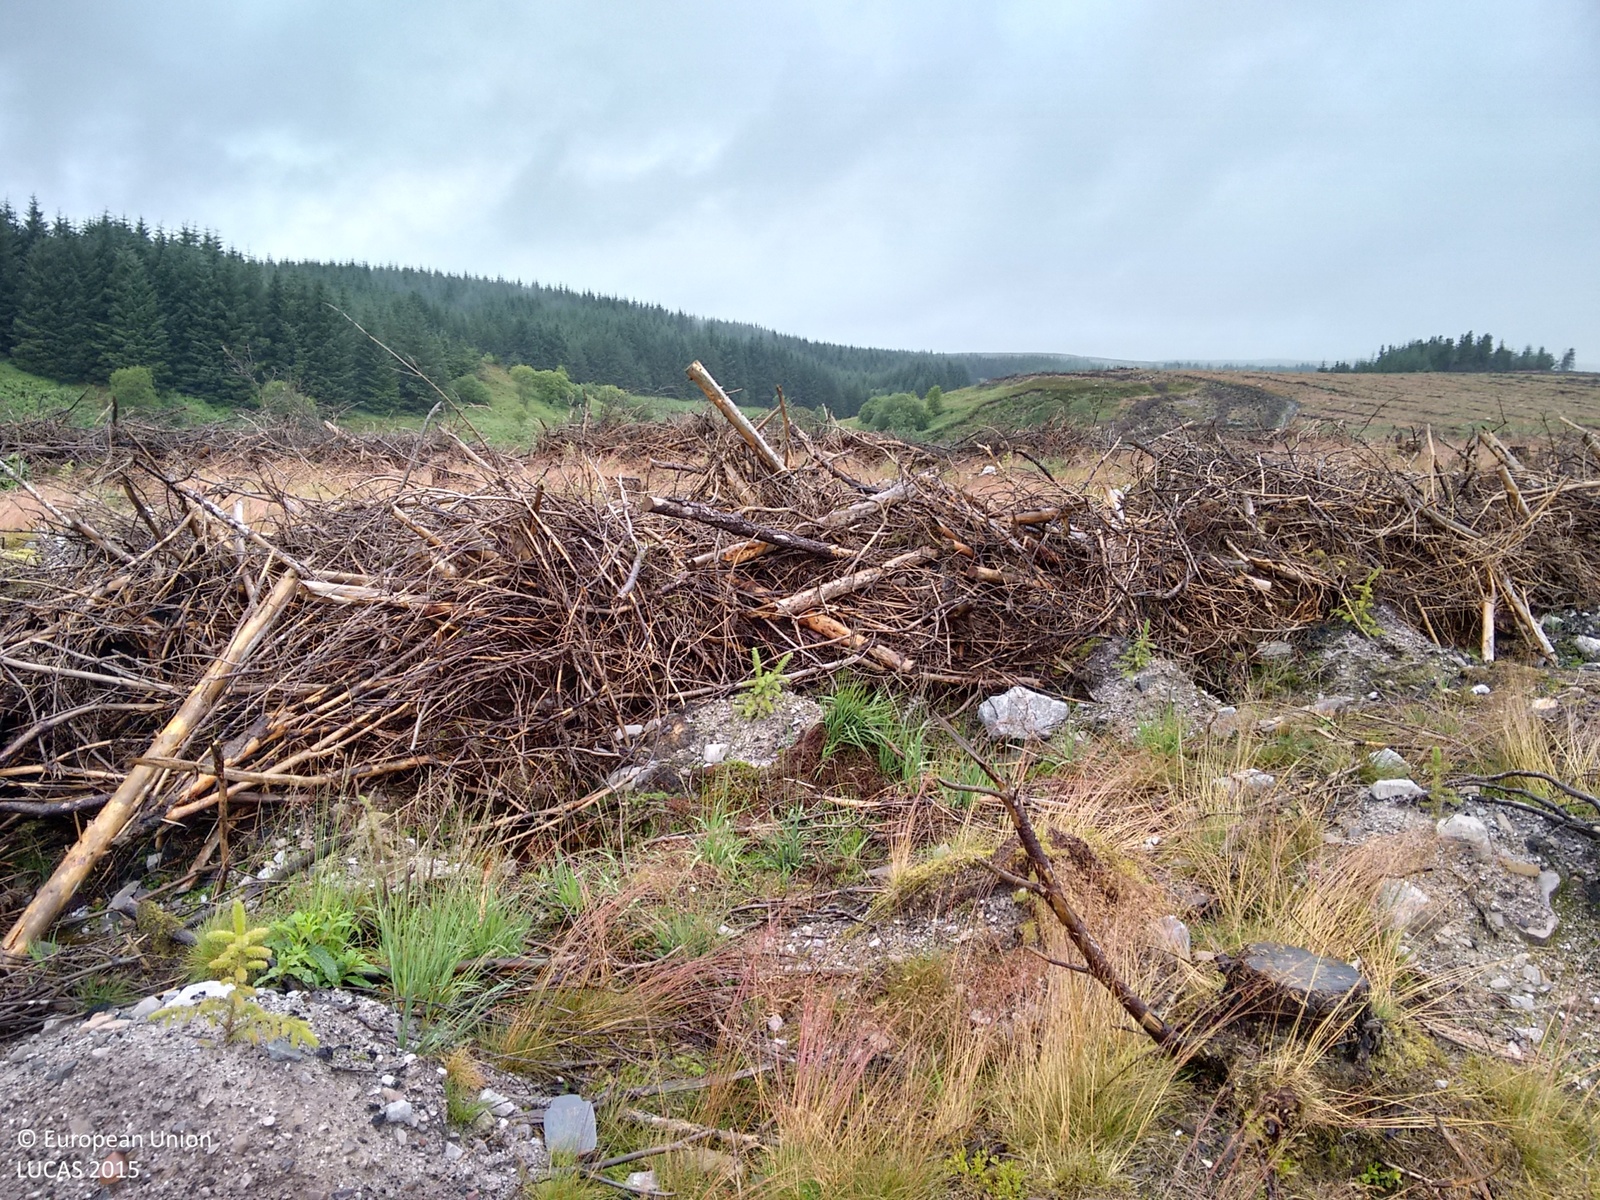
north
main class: Grassland
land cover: Spontaneously vegetated surfaces
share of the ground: > 75 %
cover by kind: herbaceous plants 70 %, unconsolidated bare surface 30 %
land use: Forestry
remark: Clear cut
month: July
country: GB
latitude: 51.8034
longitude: -3.6470
